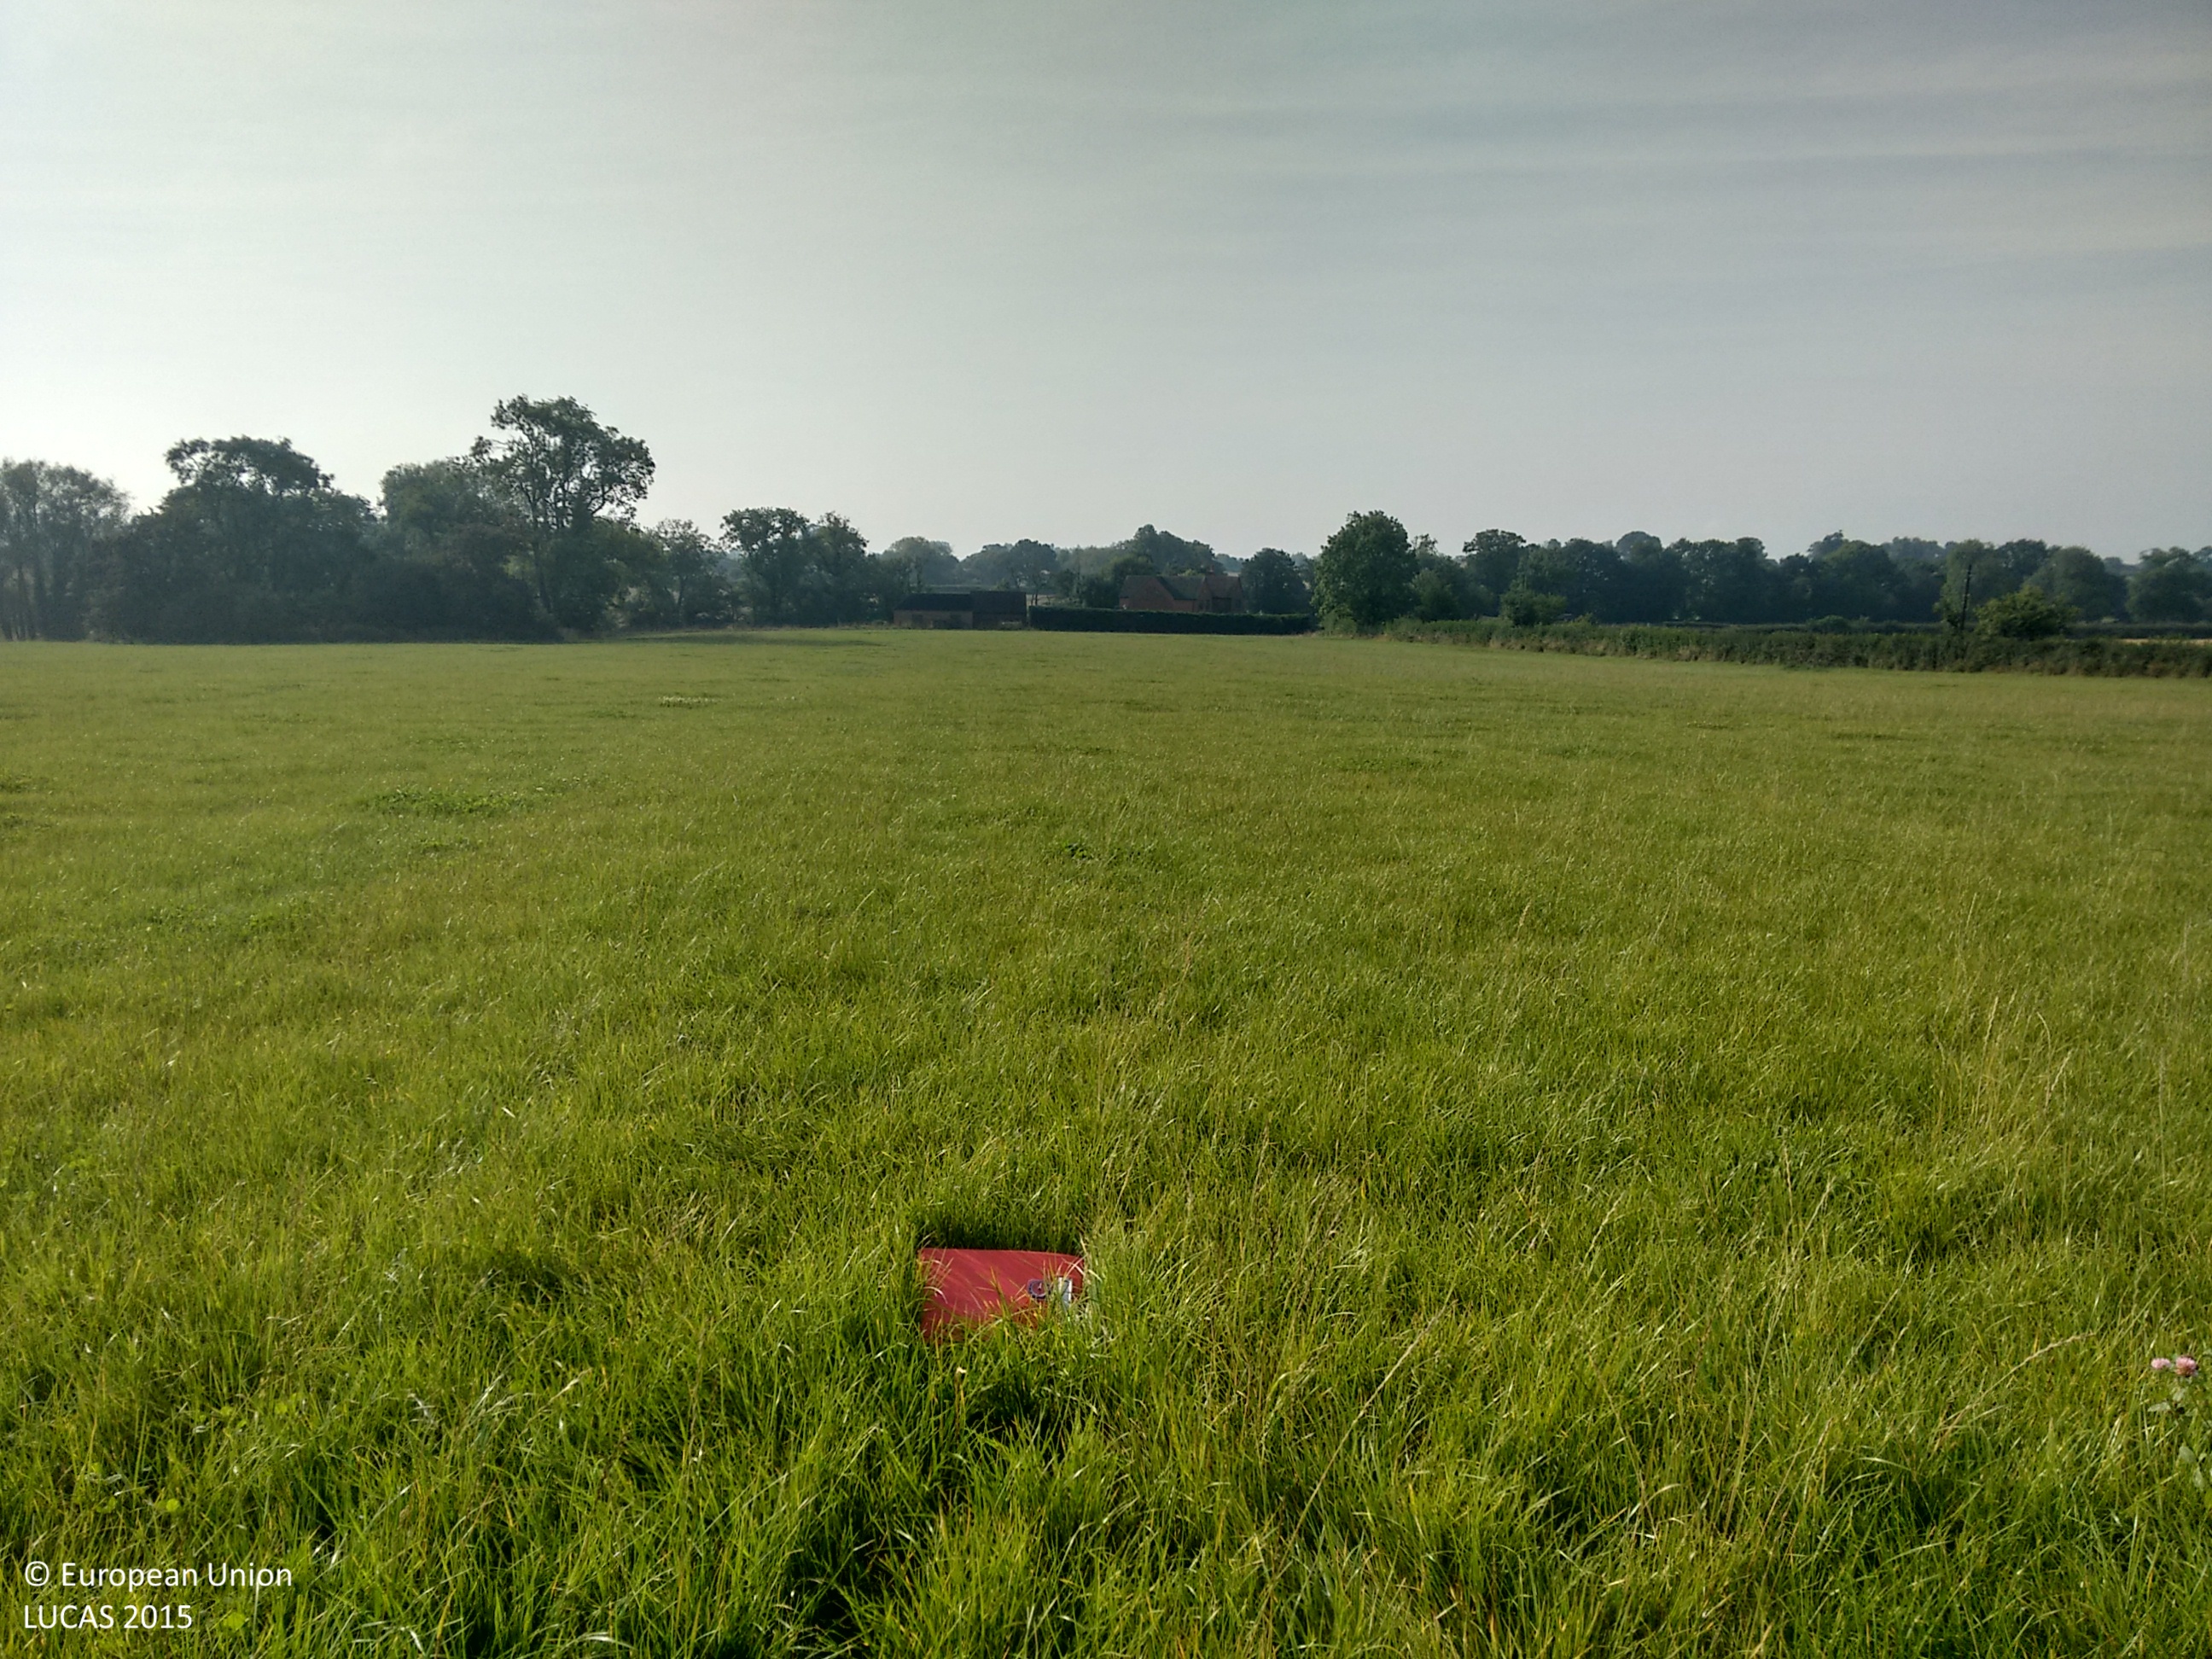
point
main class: Grassland
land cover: Grassland without tree/shrub cover
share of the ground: > 75 %
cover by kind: herbaceous plants 100 %
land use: Agriculture (excluding fallow land and kitchen gardens)
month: September
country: GB
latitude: 52.8405
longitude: -2.3410
